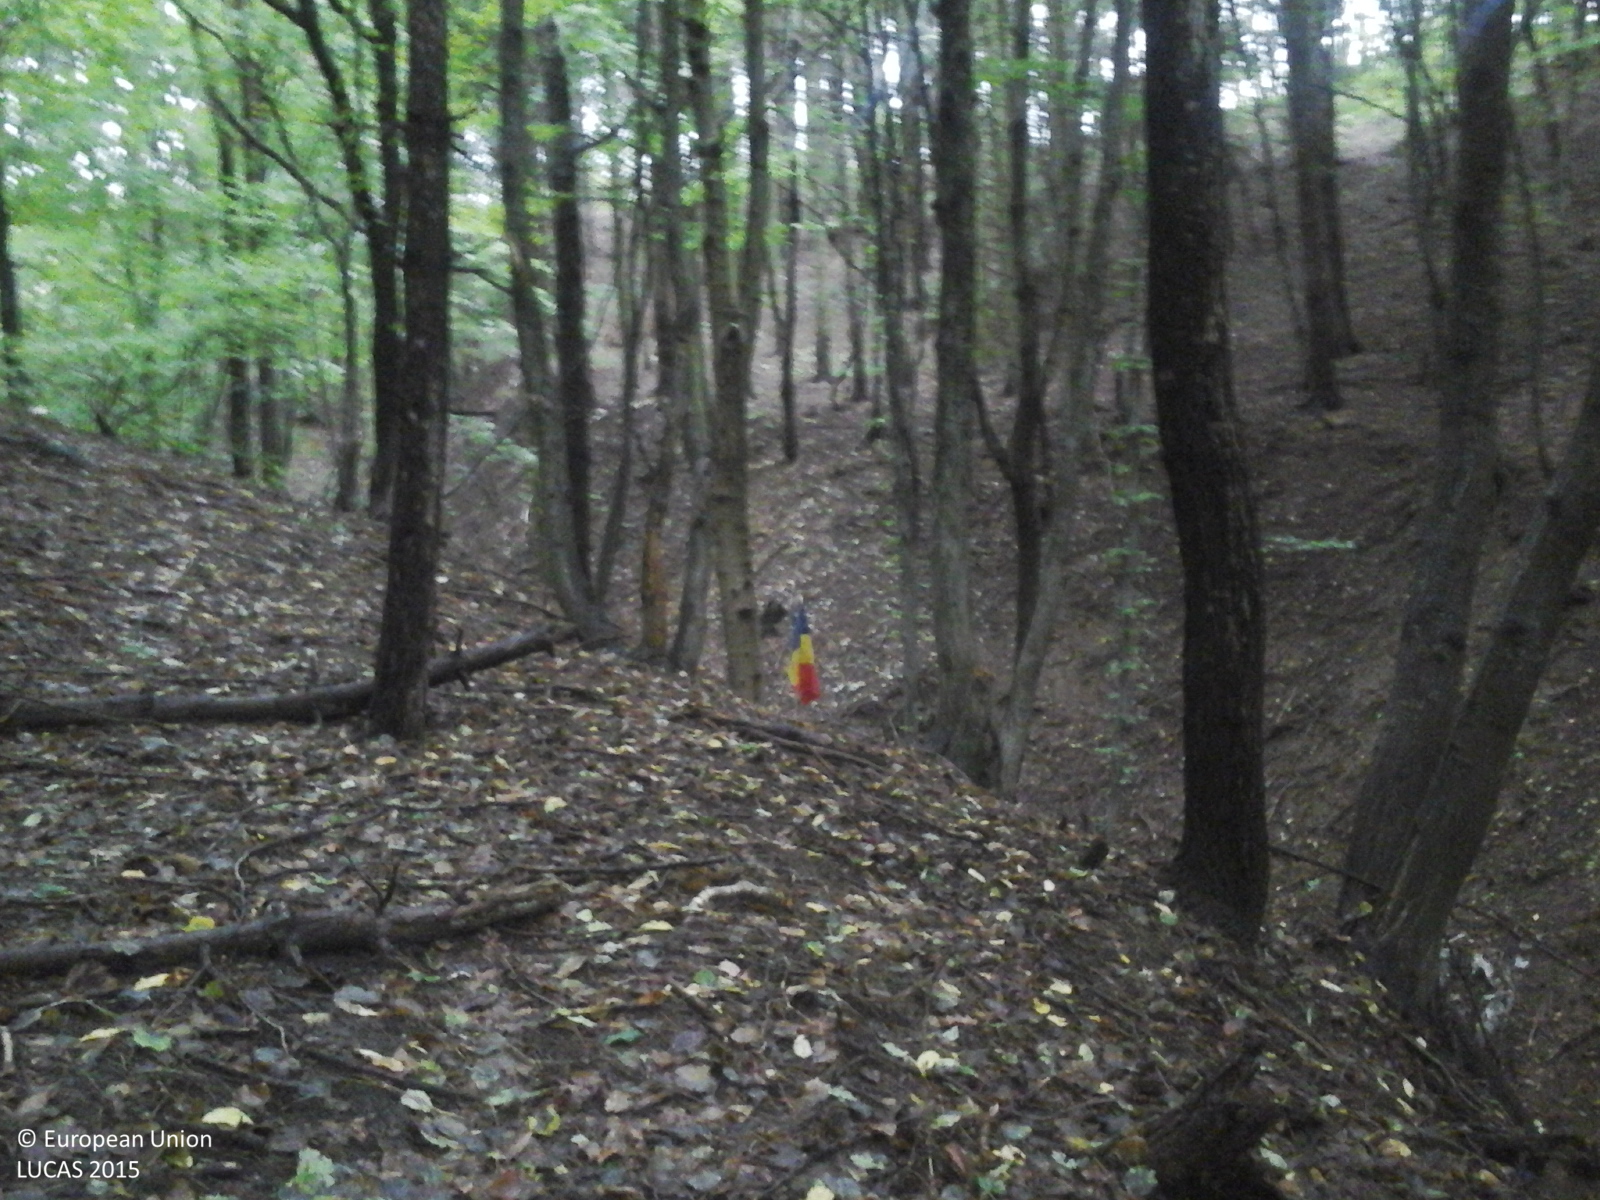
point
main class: Woodland
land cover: Other mixed woodland
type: beech forest
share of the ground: > 75 %
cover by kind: broadleaved forest trees 70 %, coniferous forest trees 30 %
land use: Forestry
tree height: > 5 m
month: September
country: RO
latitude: 45.8090
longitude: 23.7202
